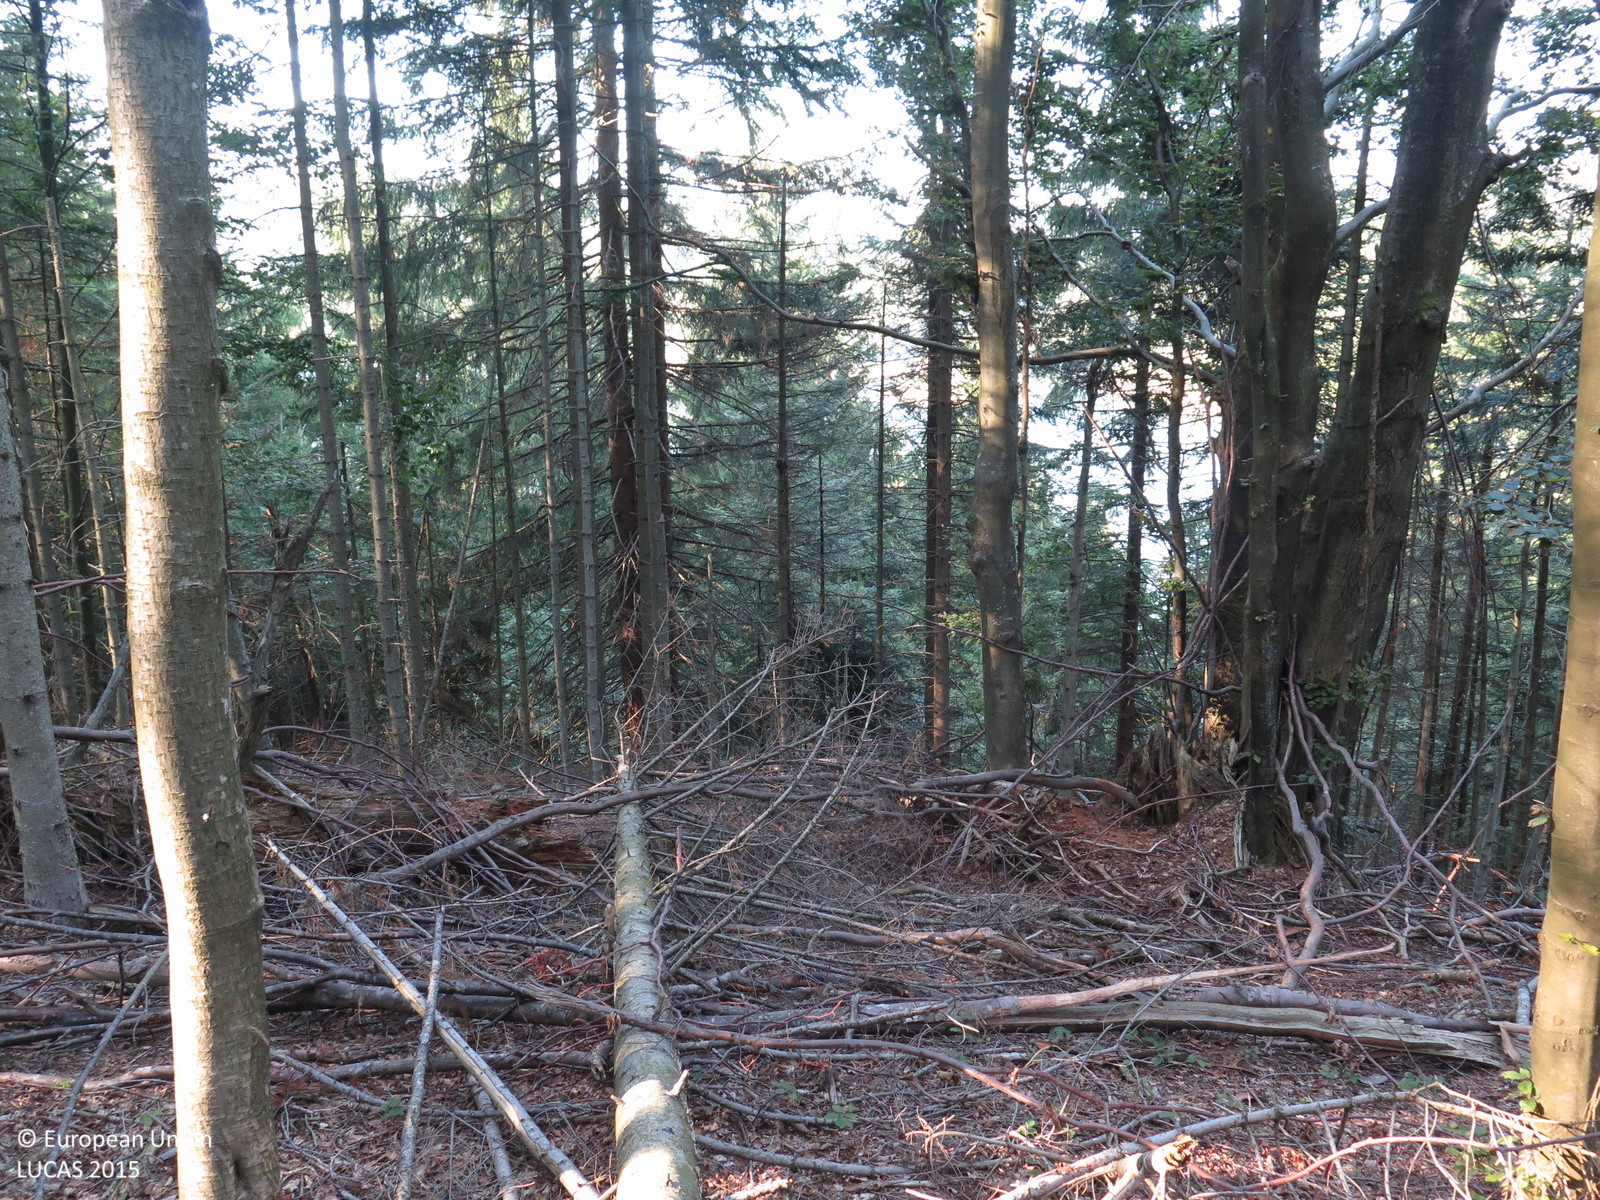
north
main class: Woodland
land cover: Other coniferous woodland
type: alpine coniferous forest
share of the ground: > 75 %
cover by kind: coniferous forest trees 90 %, herbaceous plants 5 %, unconsolidated bare surface 5 %
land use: Forestry
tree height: > 5 m
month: August
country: HR
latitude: 45.3634
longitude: 14.7061
